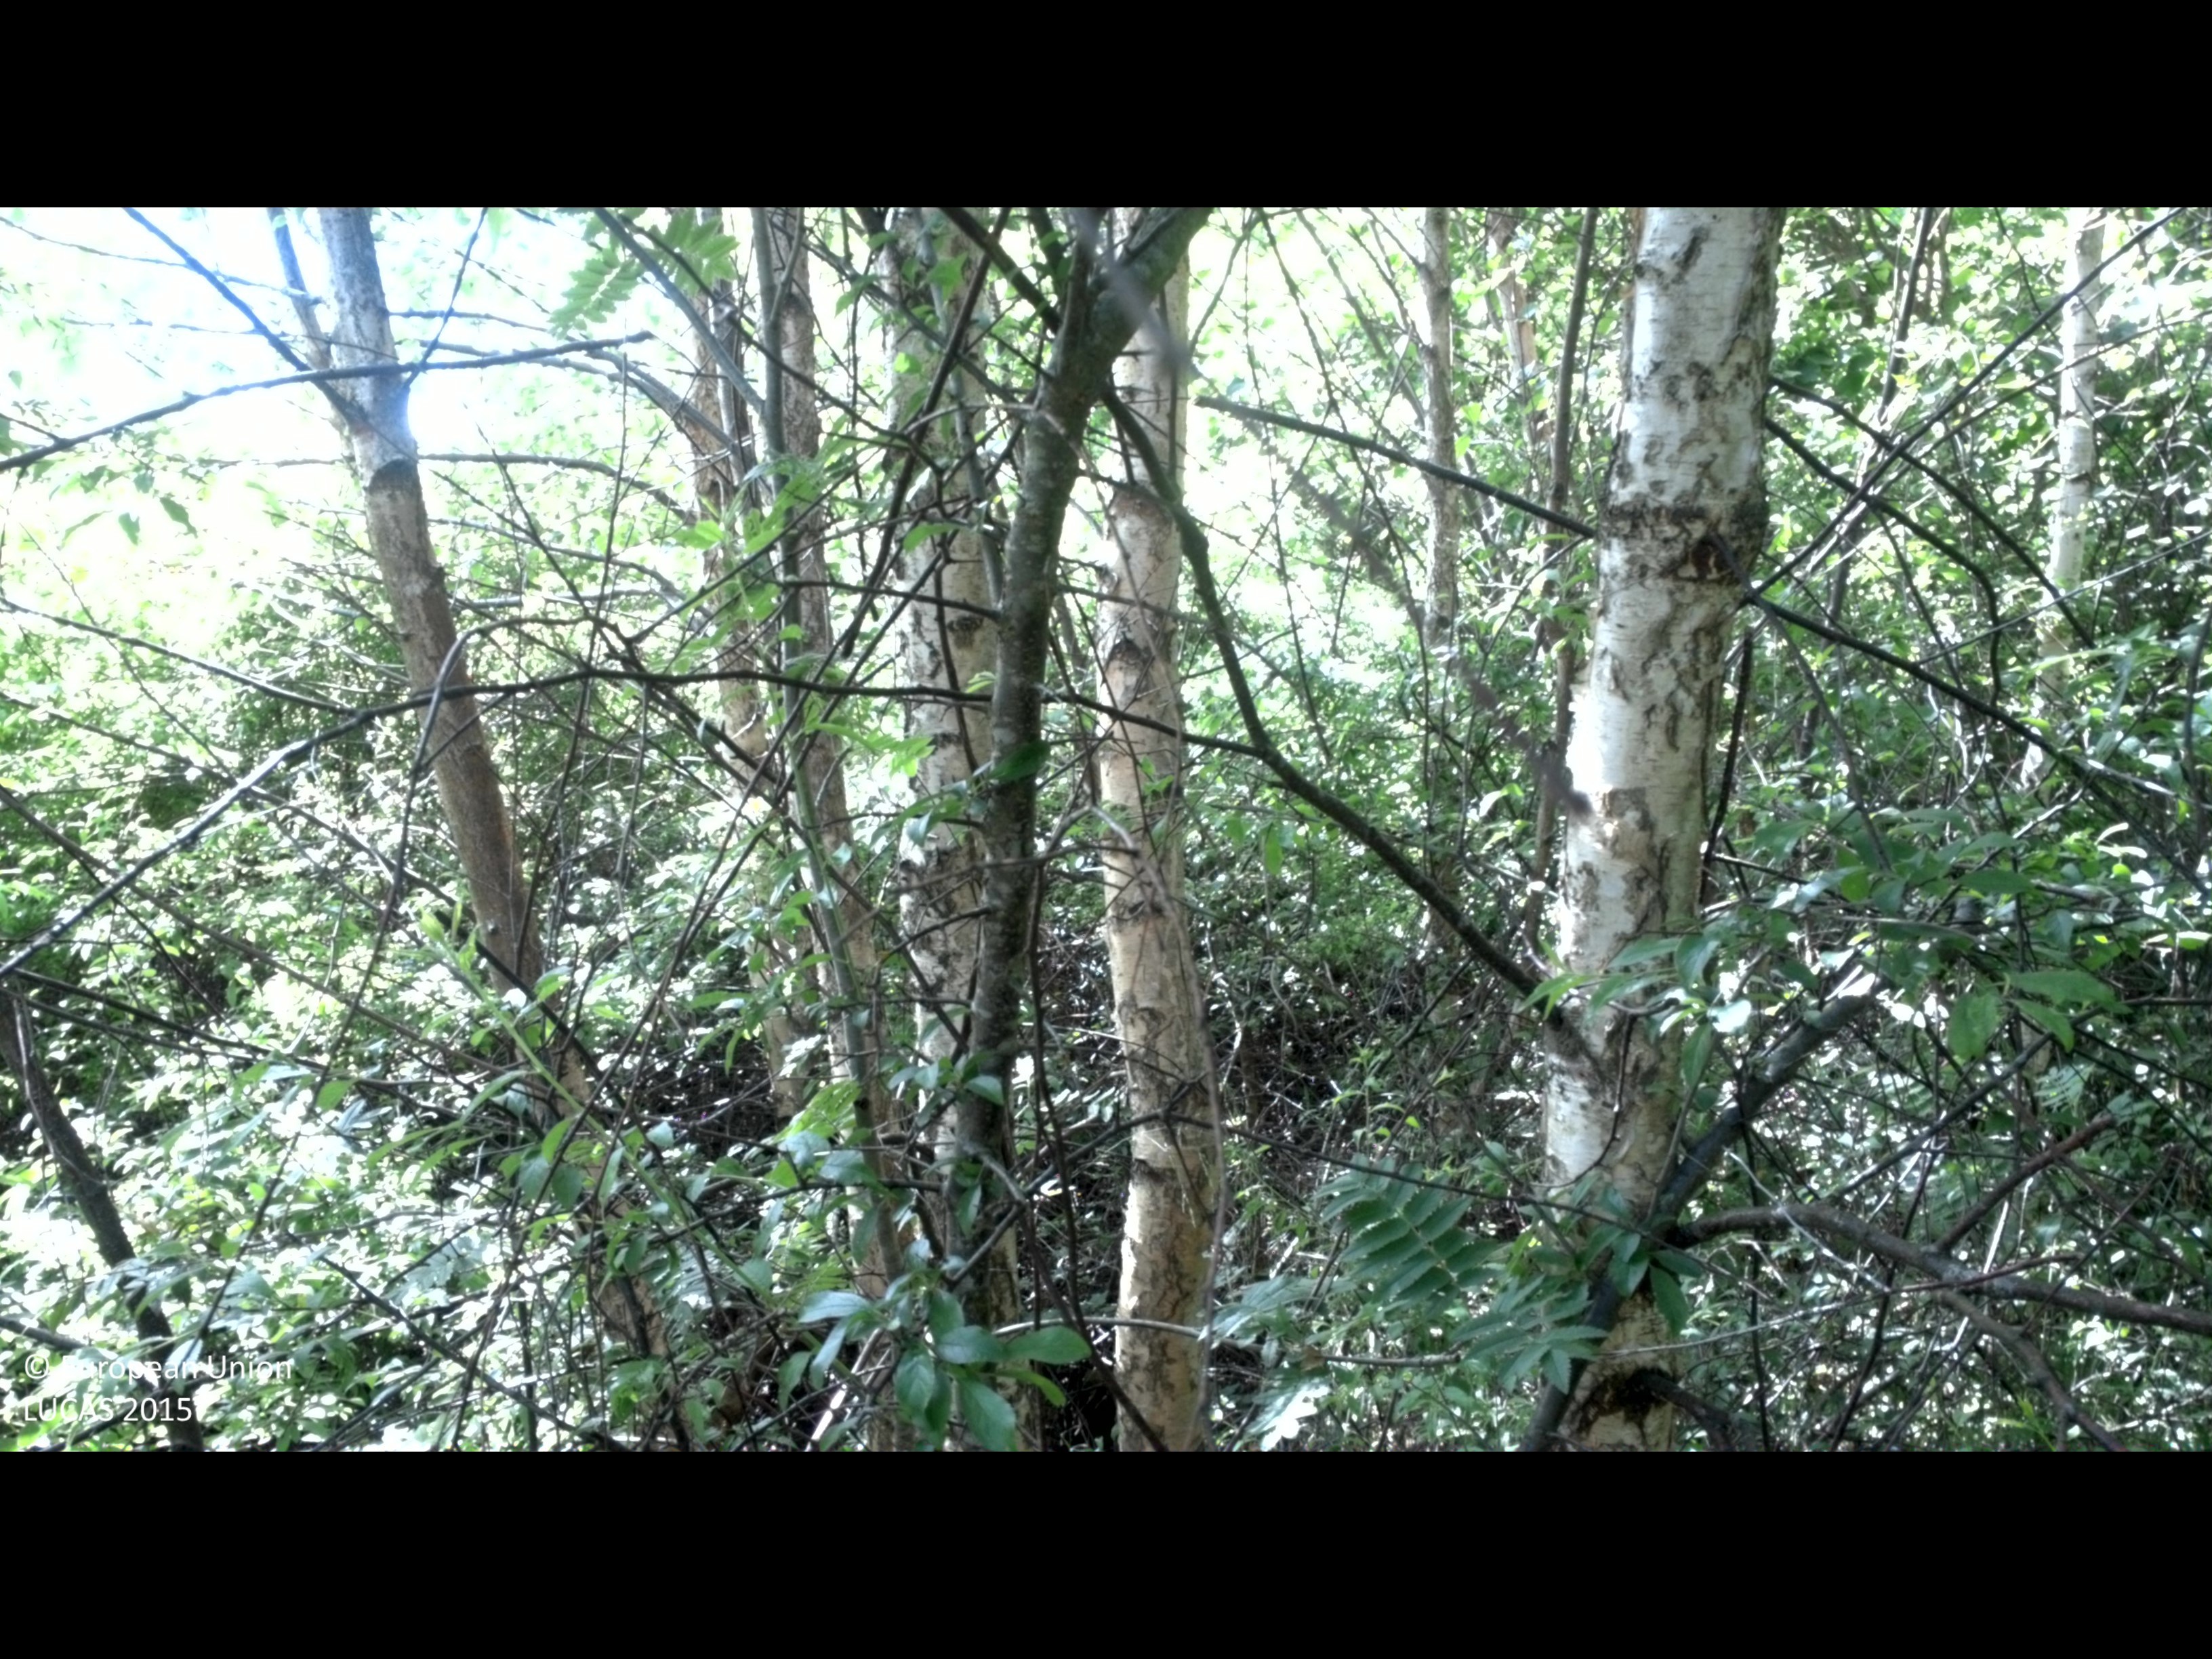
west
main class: Woodland
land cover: Broadleaved woodland
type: hemiboreal forest and nemoral coniferous forest and mixed broadleaved-coniferous forest
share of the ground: 25 - 50 %
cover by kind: shrubs 45 %, broadleaved forest trees 40 %, herbaceous plants 15 %
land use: Forestry
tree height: > 5 m
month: June
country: SE
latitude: 57.8918
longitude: 16.6615
